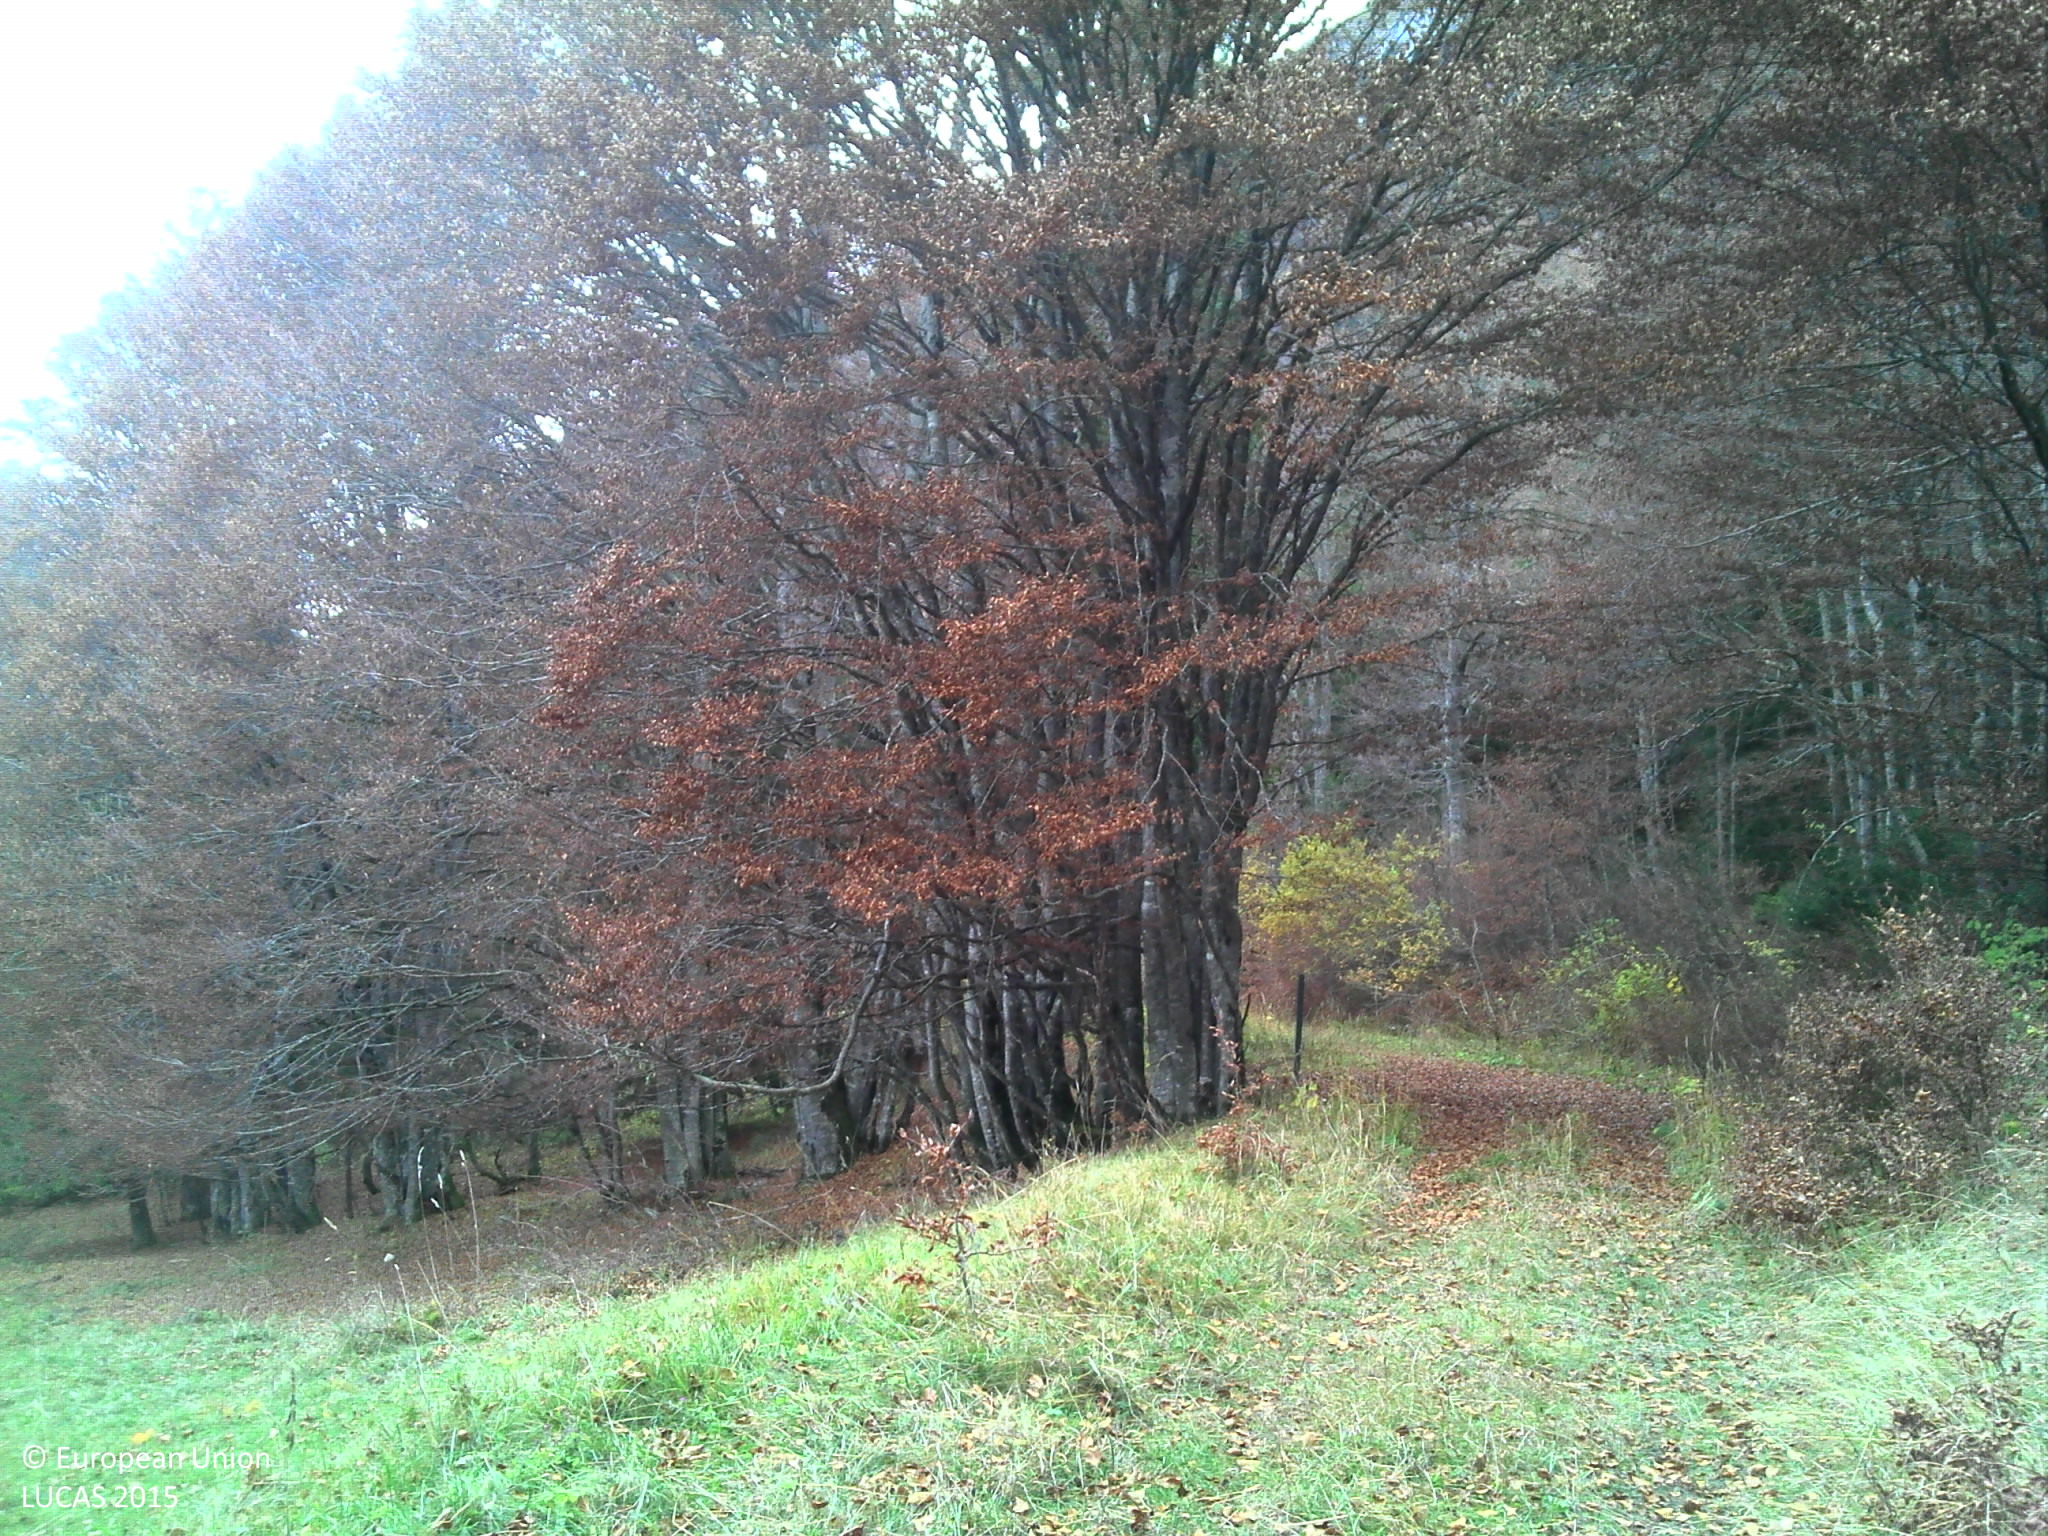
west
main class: Woodland
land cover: Spruce dominated mixed woodland
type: mountainous beech forest
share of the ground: > 75 %
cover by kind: broadleaved forest trees 50 %, coniferous forest trees 30 %, unconsolidated bare surface 15 %, shrubs 5 %
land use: Forestry
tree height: > 5 m
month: November
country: FR
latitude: 45.7863
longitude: 6.4154
